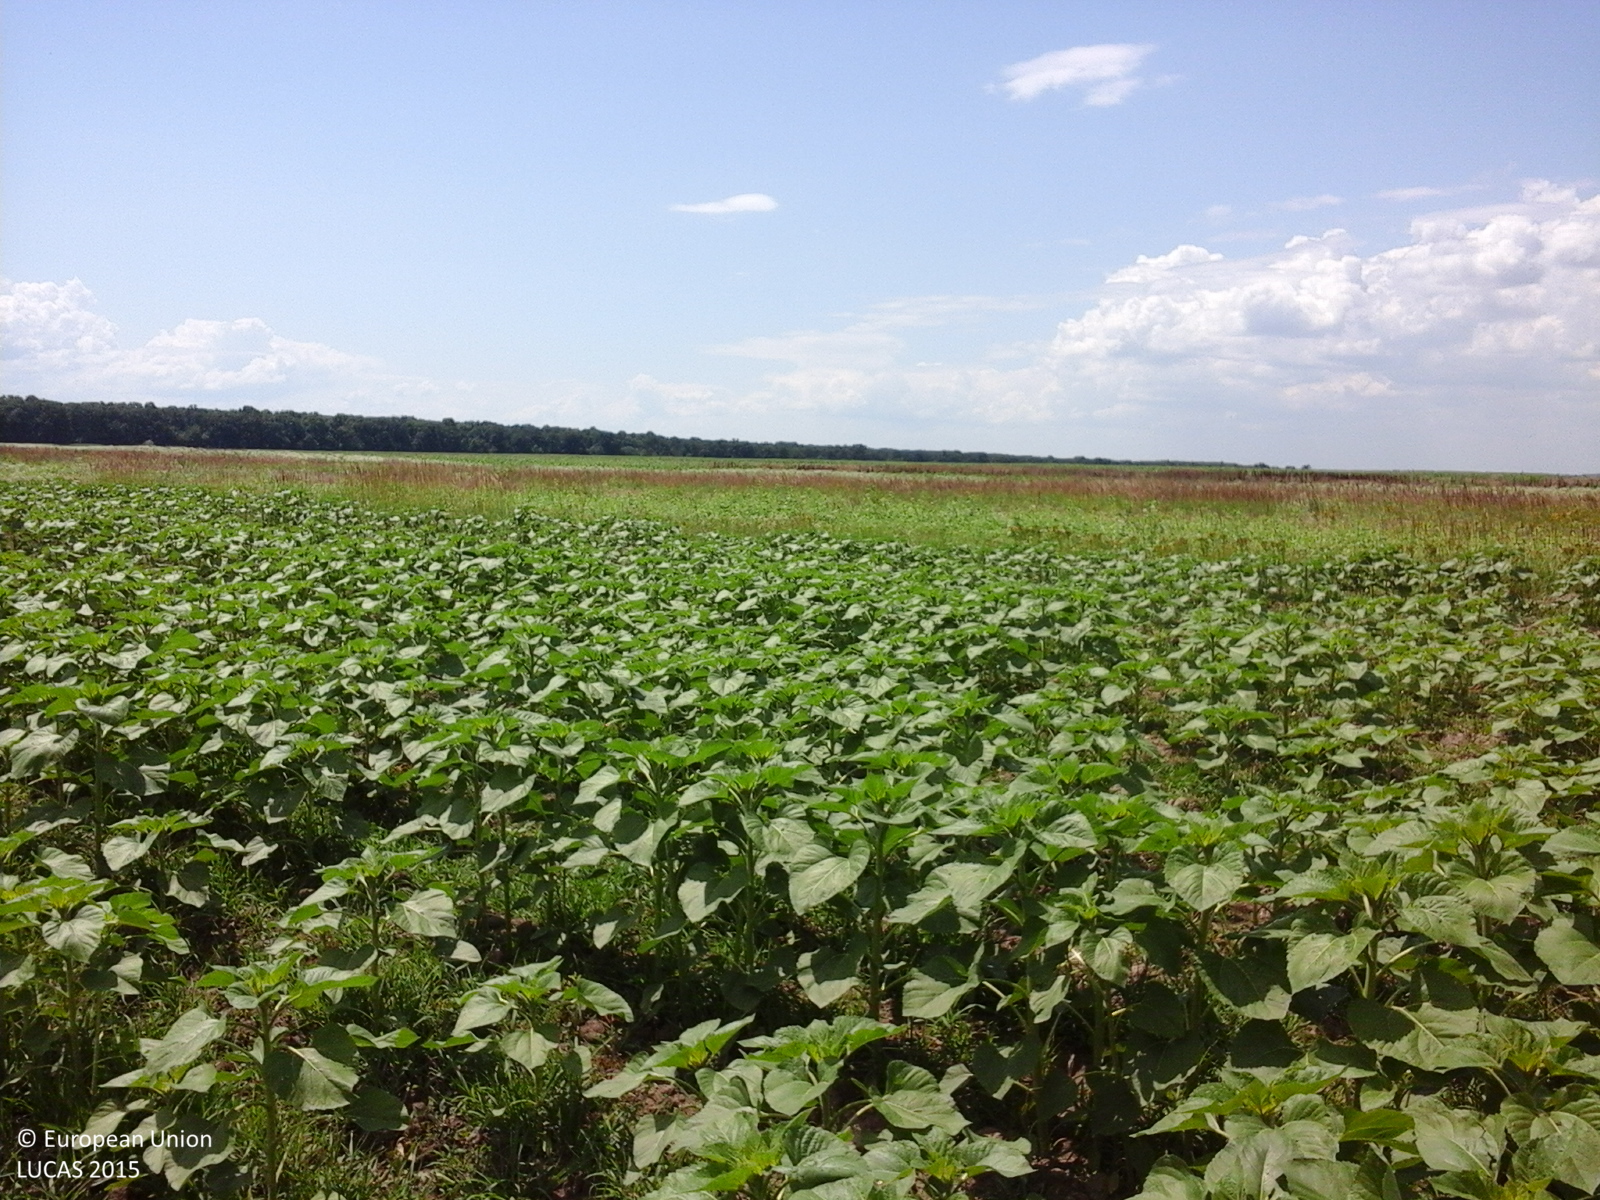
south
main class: Cropland
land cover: Sunflower
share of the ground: 50 - 75 %
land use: Agriculture (excluding fallow land and kitchen gardens)
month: July
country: RO
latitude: 44.3914
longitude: 25.5967
